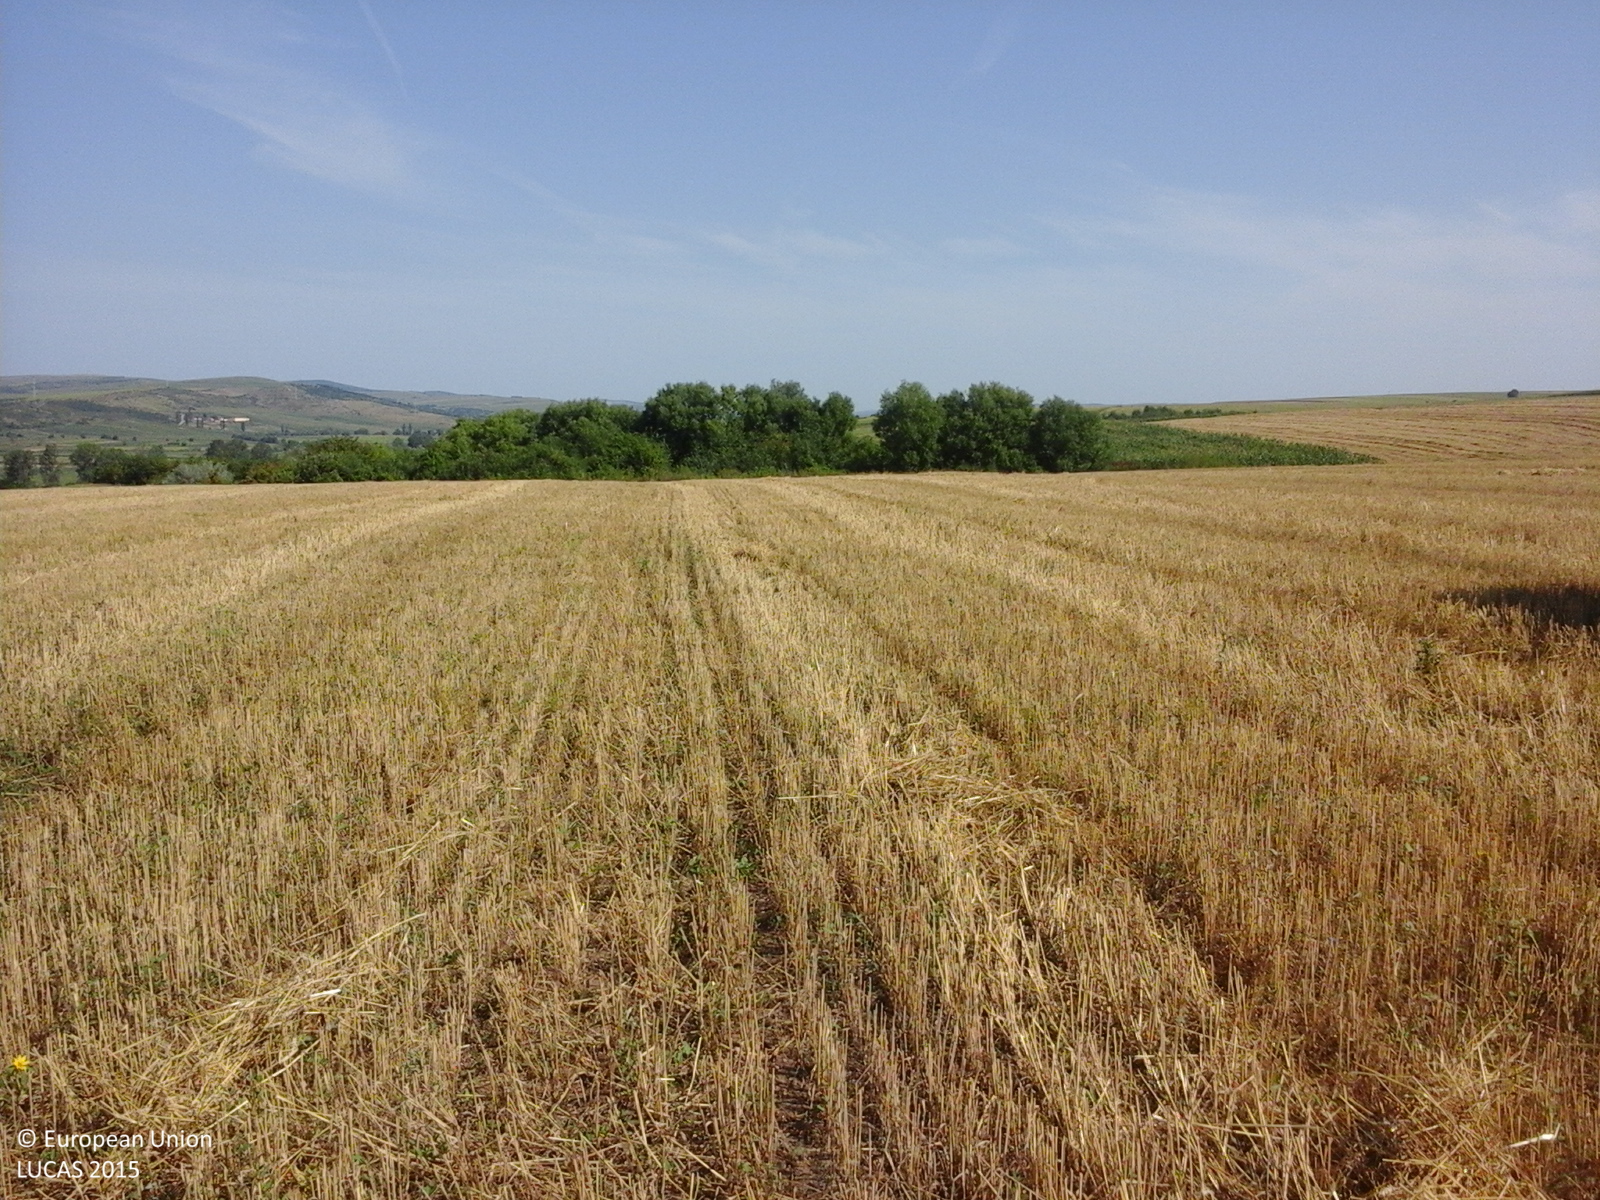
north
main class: Cropland
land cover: Common wheat
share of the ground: > 75 %
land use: Agriculture (excluding fallow land and kitchen gardens)
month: July
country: RO
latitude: 46.1762
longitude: 27.3180
